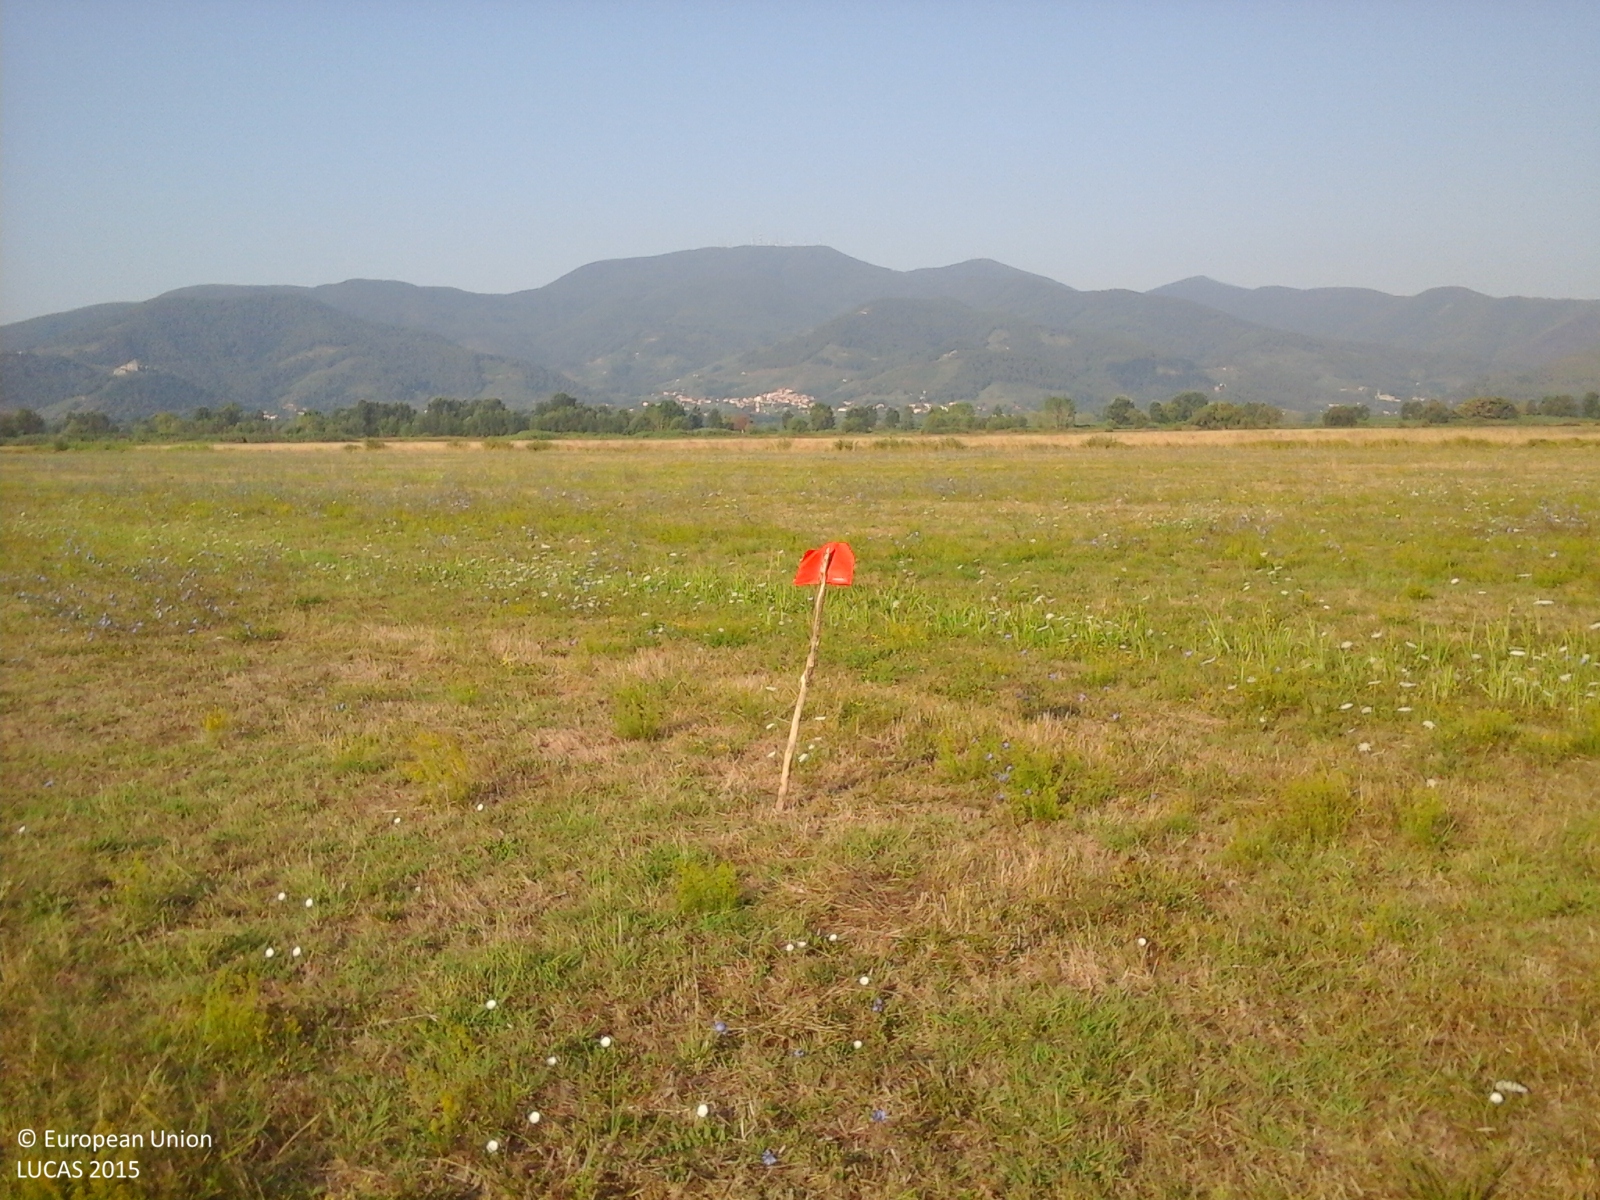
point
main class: Cropland
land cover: Temporary grasslands
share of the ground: > 75 %
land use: Agriculture (excluding fallow land and kitchen gardens)
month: August
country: IT
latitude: 43.7894
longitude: 10.6321
